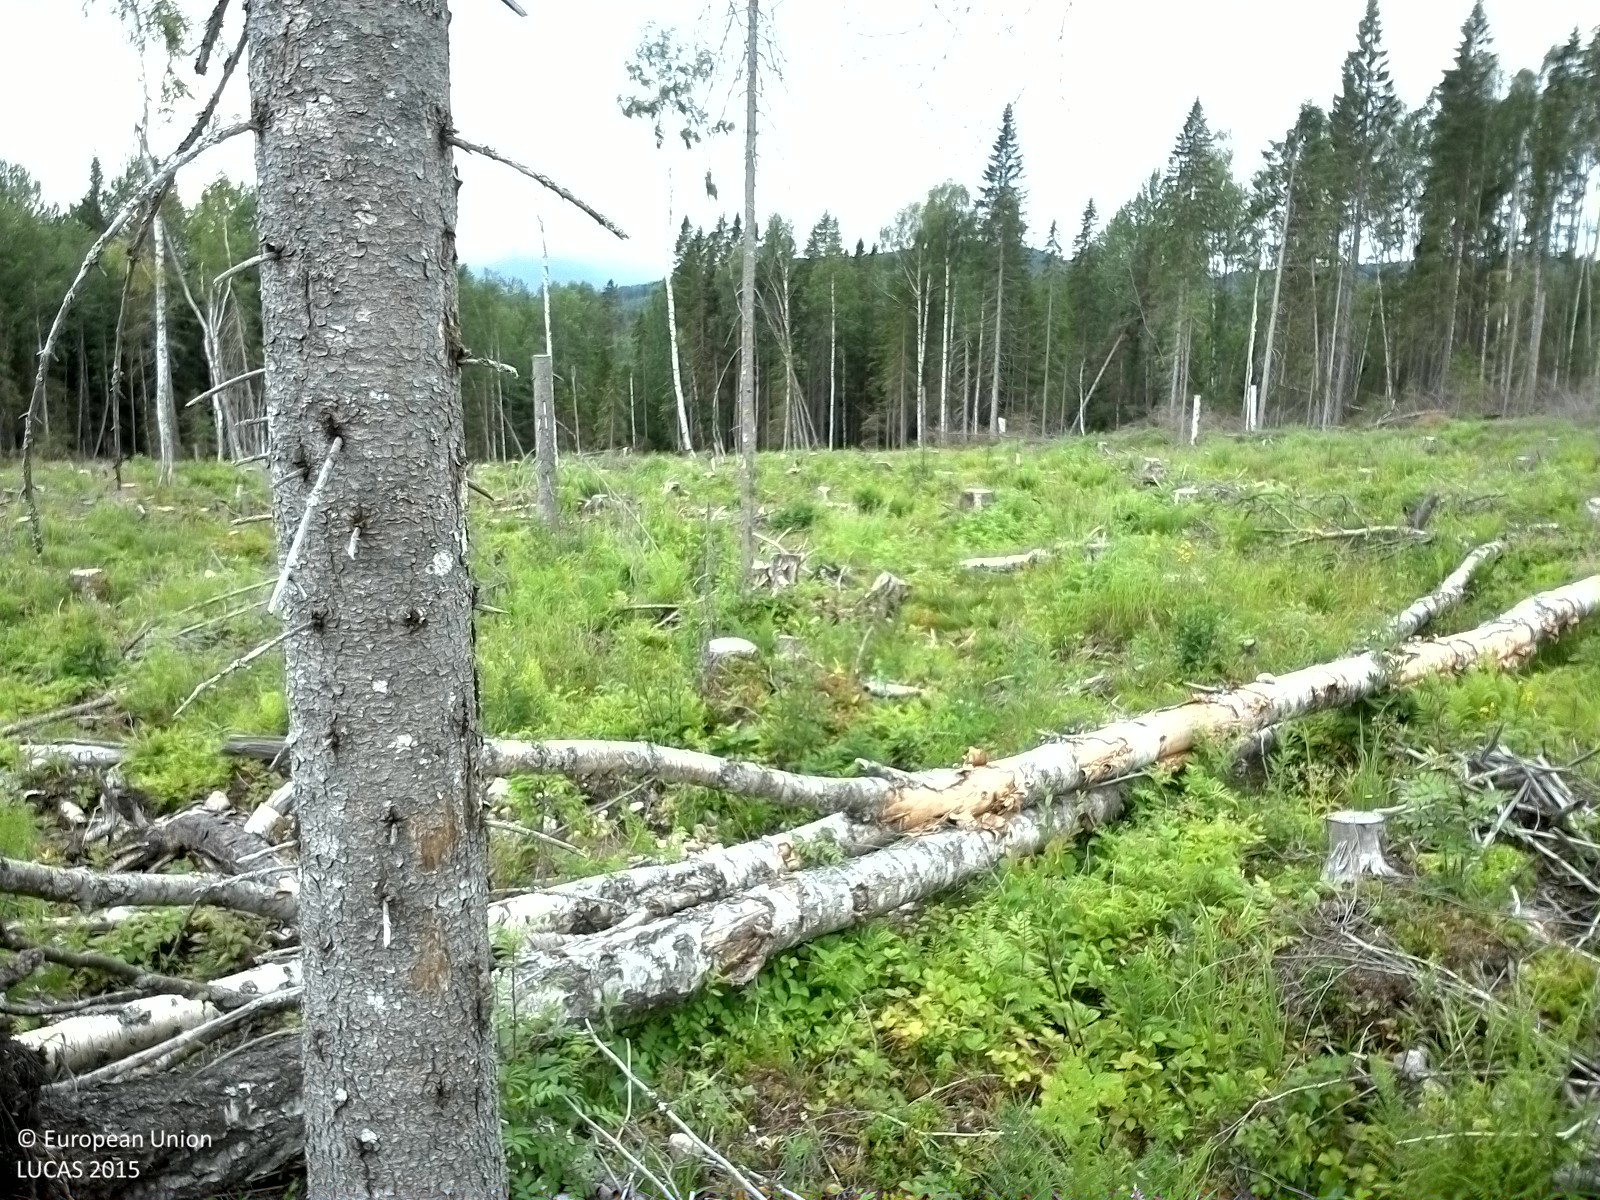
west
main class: Woodland
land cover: Broadleaved woodland
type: boreal forest
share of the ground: 10 - 25 %
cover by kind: shrubs 30 %, herbaceous plants 30 %, broadleaved forest trees 15 %
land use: Forestry
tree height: < 5 m
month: July
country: SE
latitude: 62.0887
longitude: 16.9712
